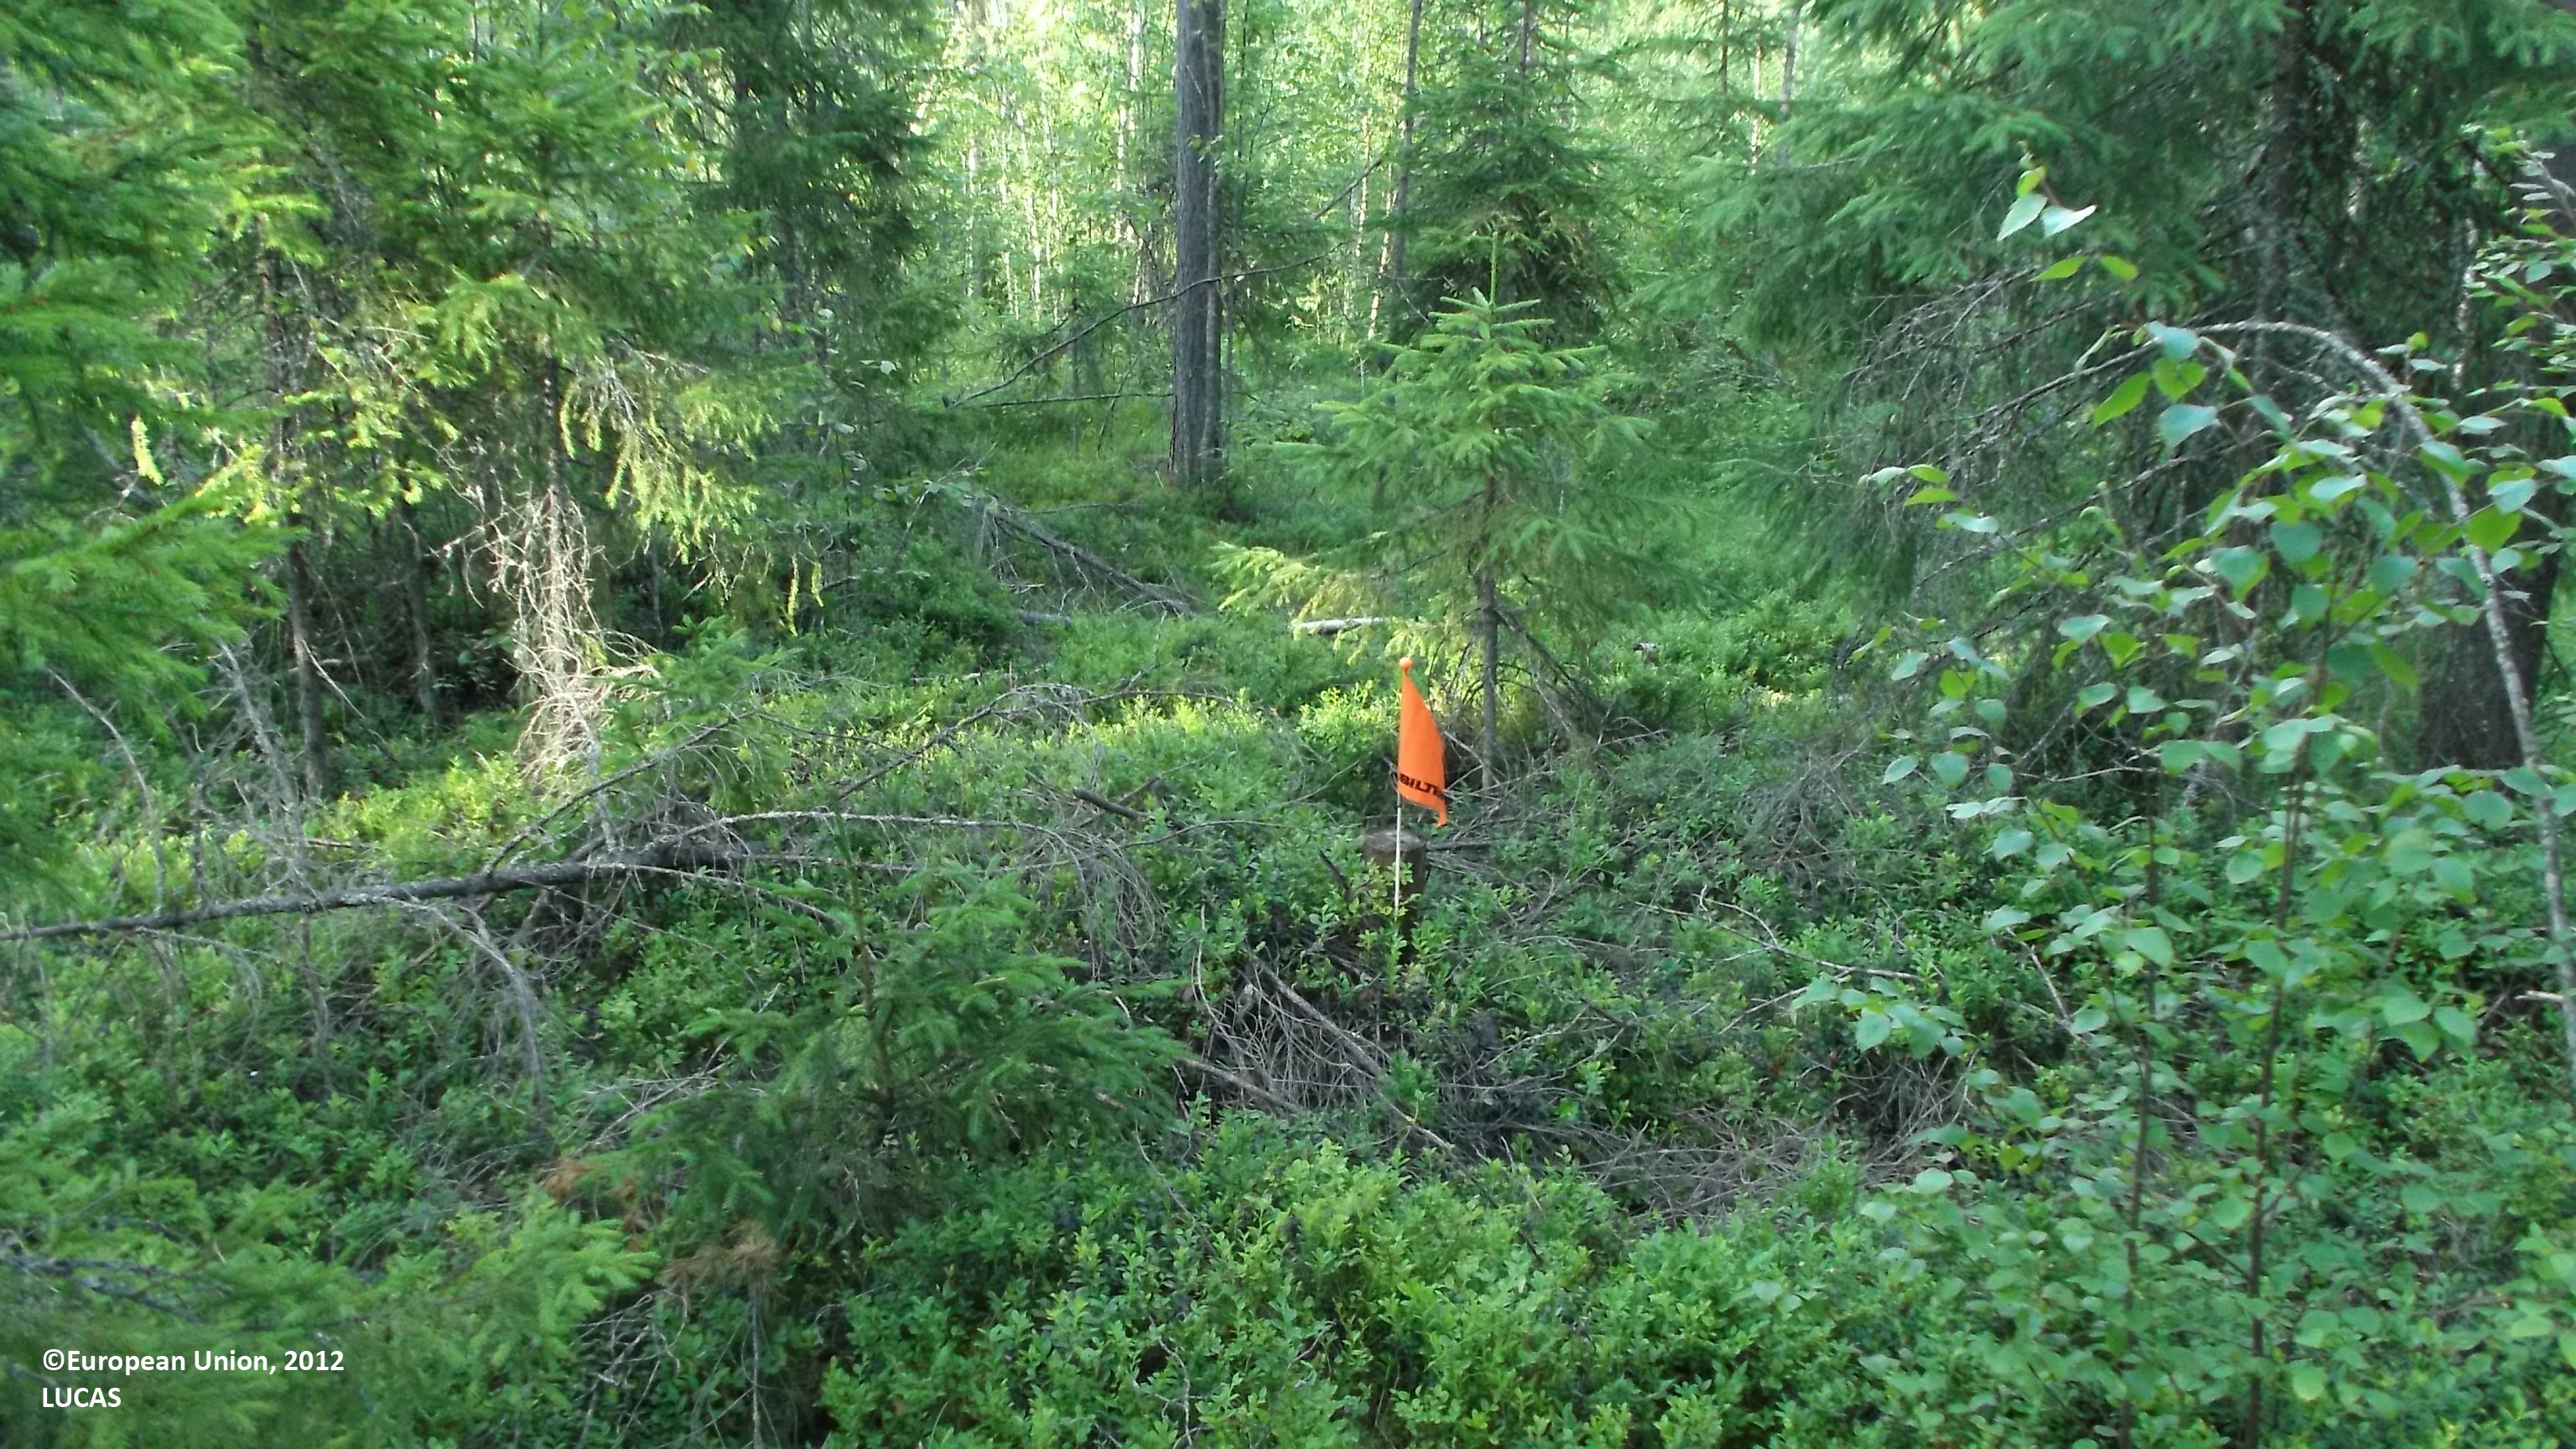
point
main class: Woodland
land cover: Other coniferous woodland
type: boreal forest
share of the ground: 25 - 50 %
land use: Forestry
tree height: > 5 m
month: July
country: FI
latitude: 63.2026
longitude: 23.8081
